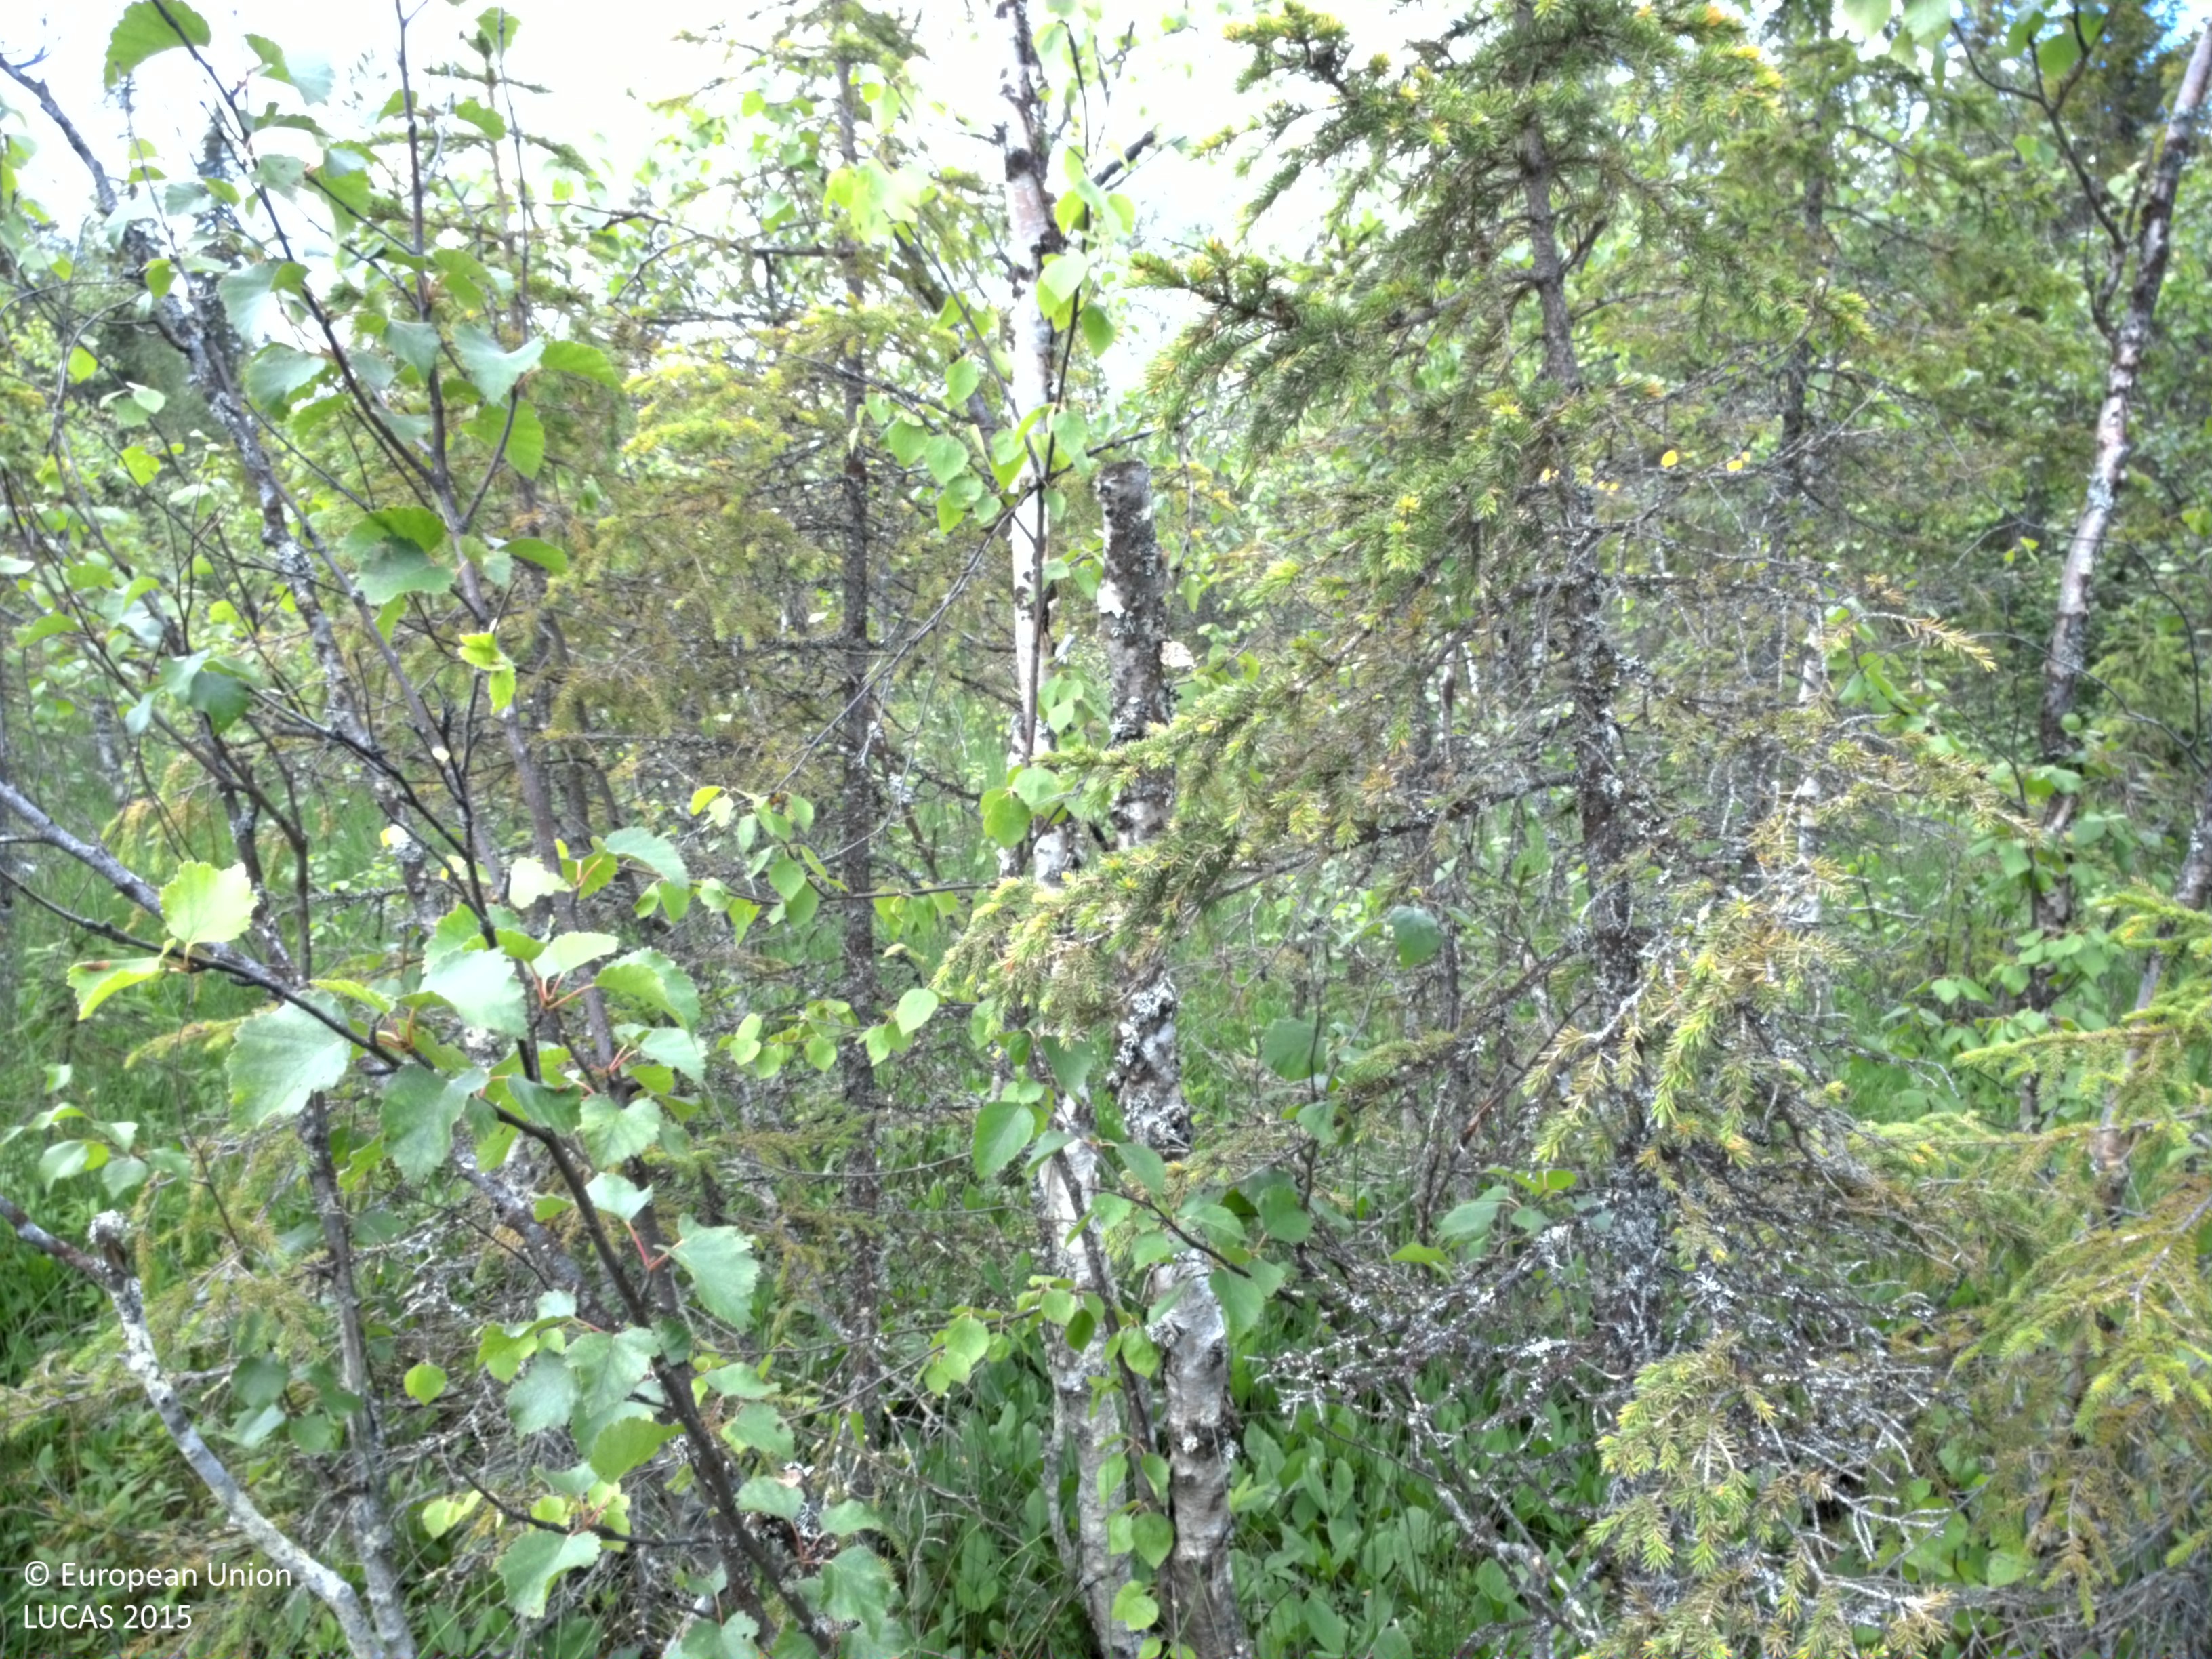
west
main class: Woodland
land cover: Broadleaved woodland
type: mire and swamp forests
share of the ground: 25 - 50 %
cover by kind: herbaceous plants 45 %, broadleaved forest trees 30 %, shrubs 10 %, coniferous forest trees 5 %
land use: Semi-natural and natural areas not in use
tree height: < 5 m
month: August
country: SE
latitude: 66.5139
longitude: 20.8187
